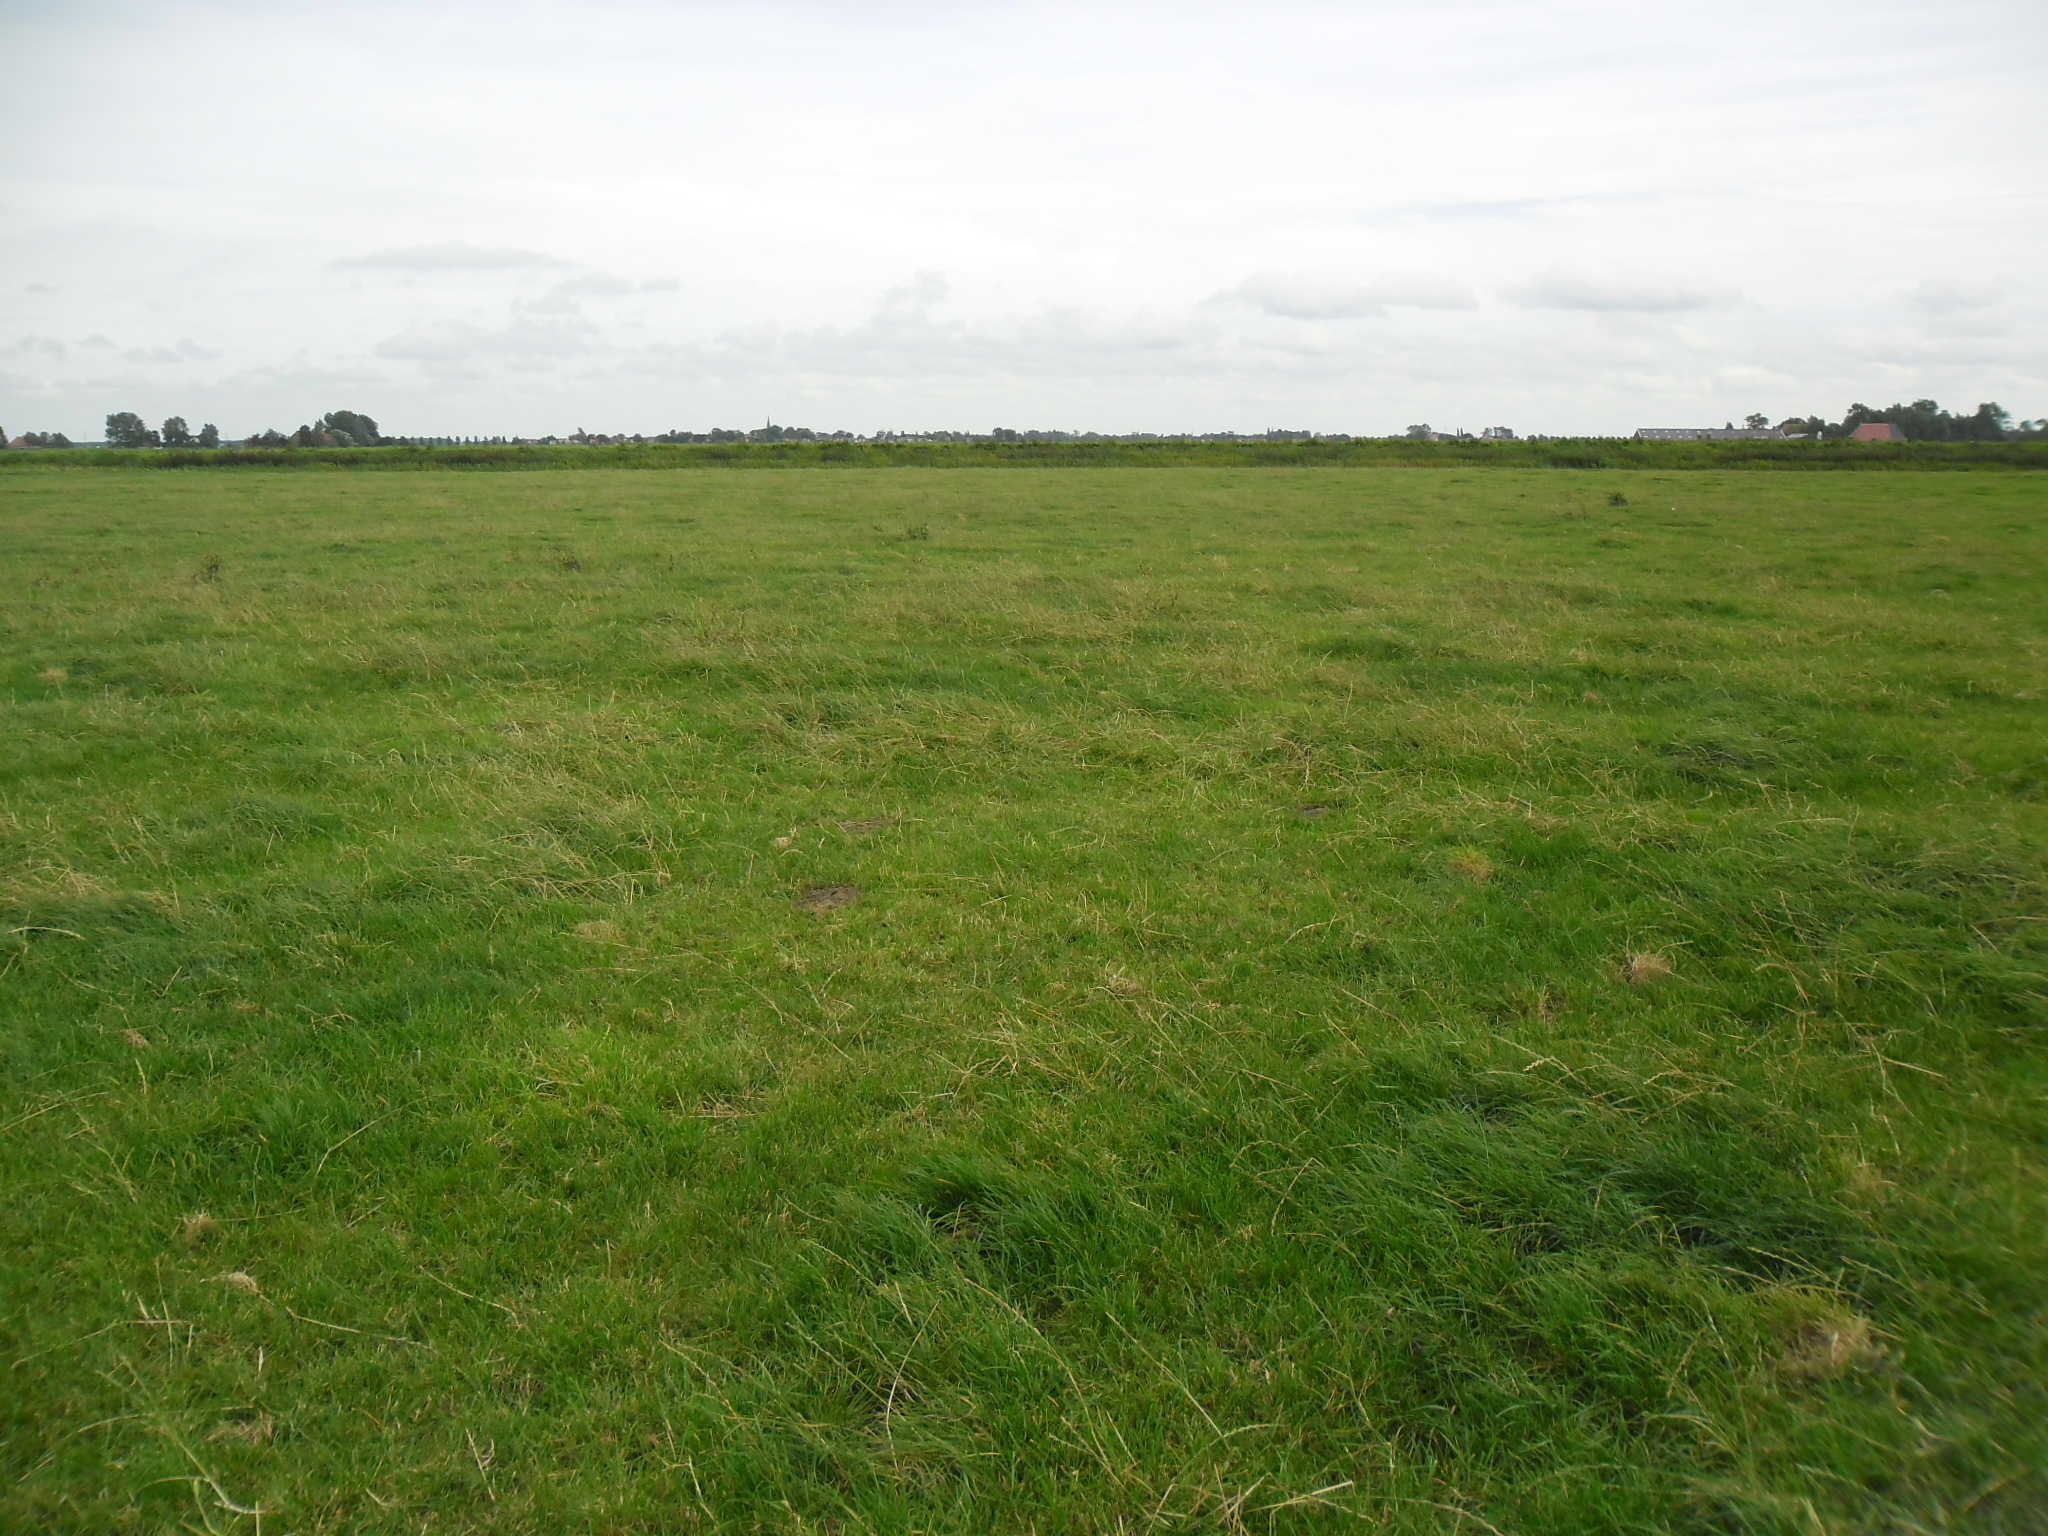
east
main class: Grassland
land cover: Grassland without tree/shrub cover
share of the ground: > 75 %
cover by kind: herbaceous plants 100 %
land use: Agriculture (excluding fallow land and kitchen gardens)
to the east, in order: Grassland without tree/shrub cover; Ditches and canals; Shruby margins; Grass margins; Paved roads, cycling and walking lanes; Grass margins; Shruby margins; Inland fresh running water; Grassland without tree/shrub cover
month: August
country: NL
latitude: 53.0150
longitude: 5.5718
